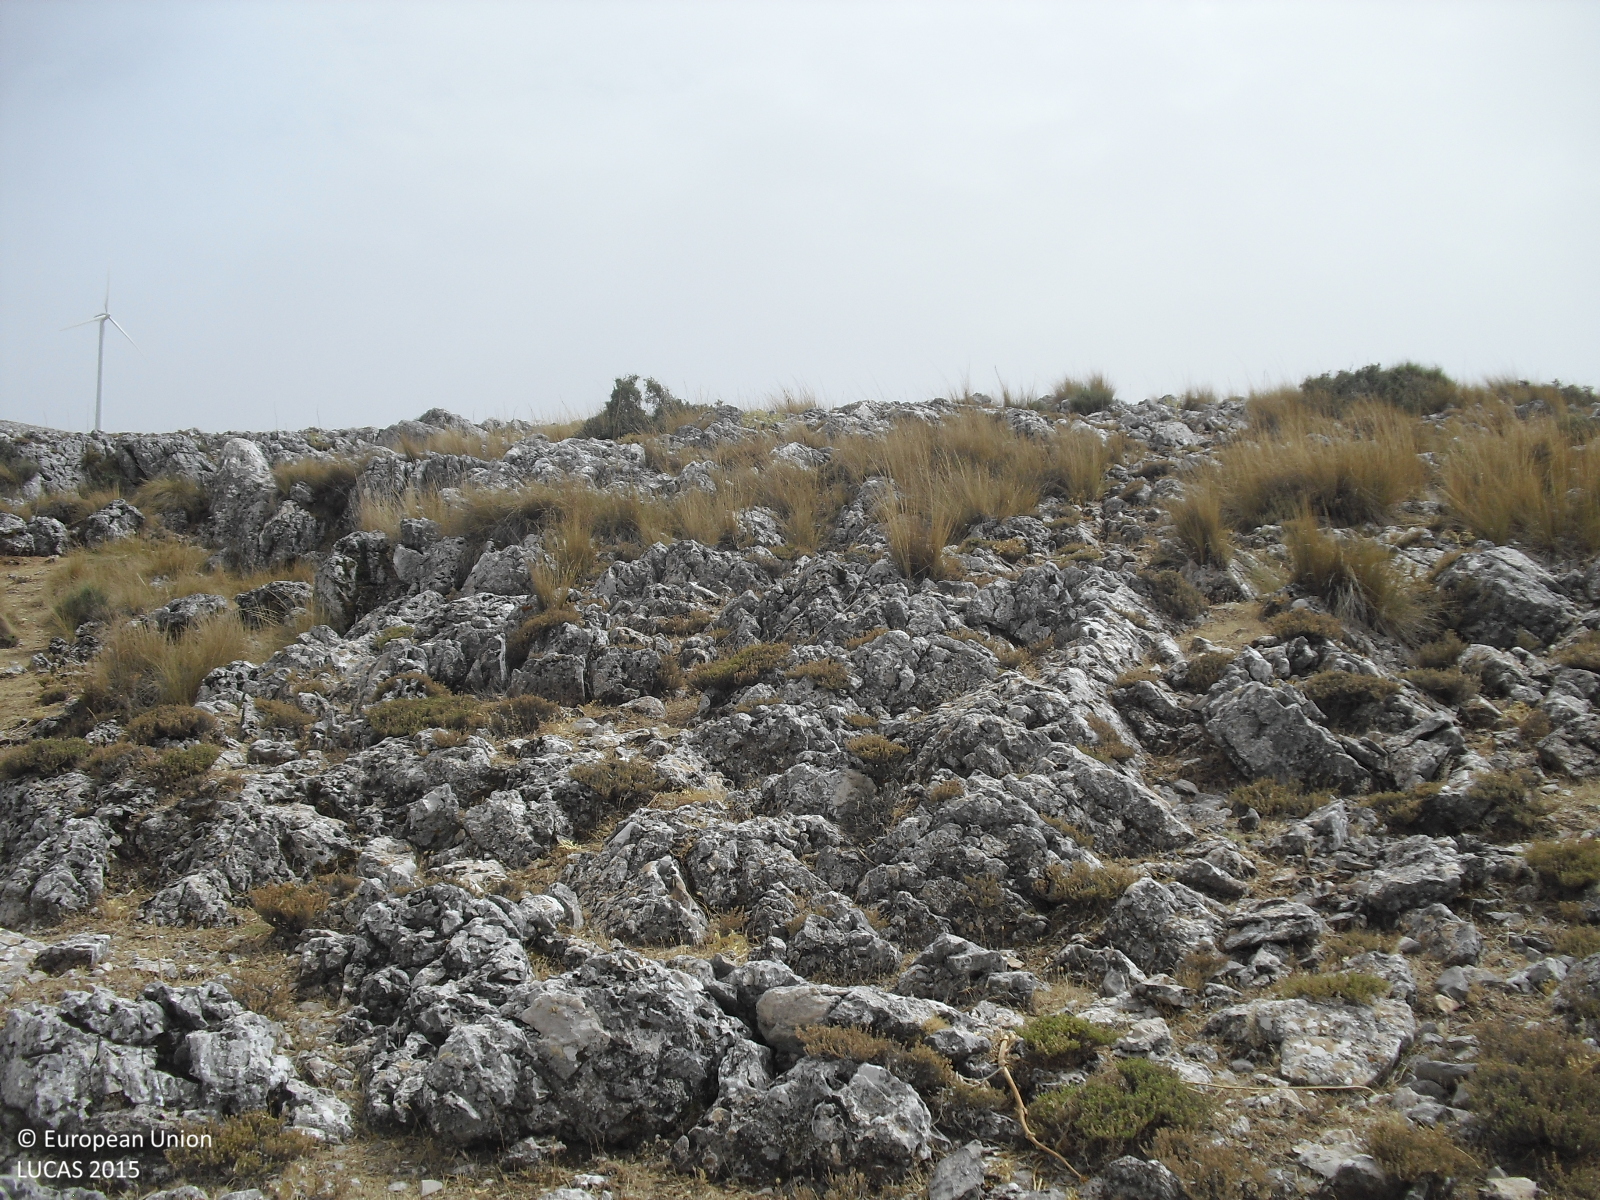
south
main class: Shrubland
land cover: Shrubland without tree cover
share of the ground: 10 - 25 %
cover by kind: herbaceous plants 40 %, consolidated bare surface 40 %, shrubs 20 %
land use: Agriculture (excluding fallow land and kitchen gardens)
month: August
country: ES
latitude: 37.1226
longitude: -4.1642
